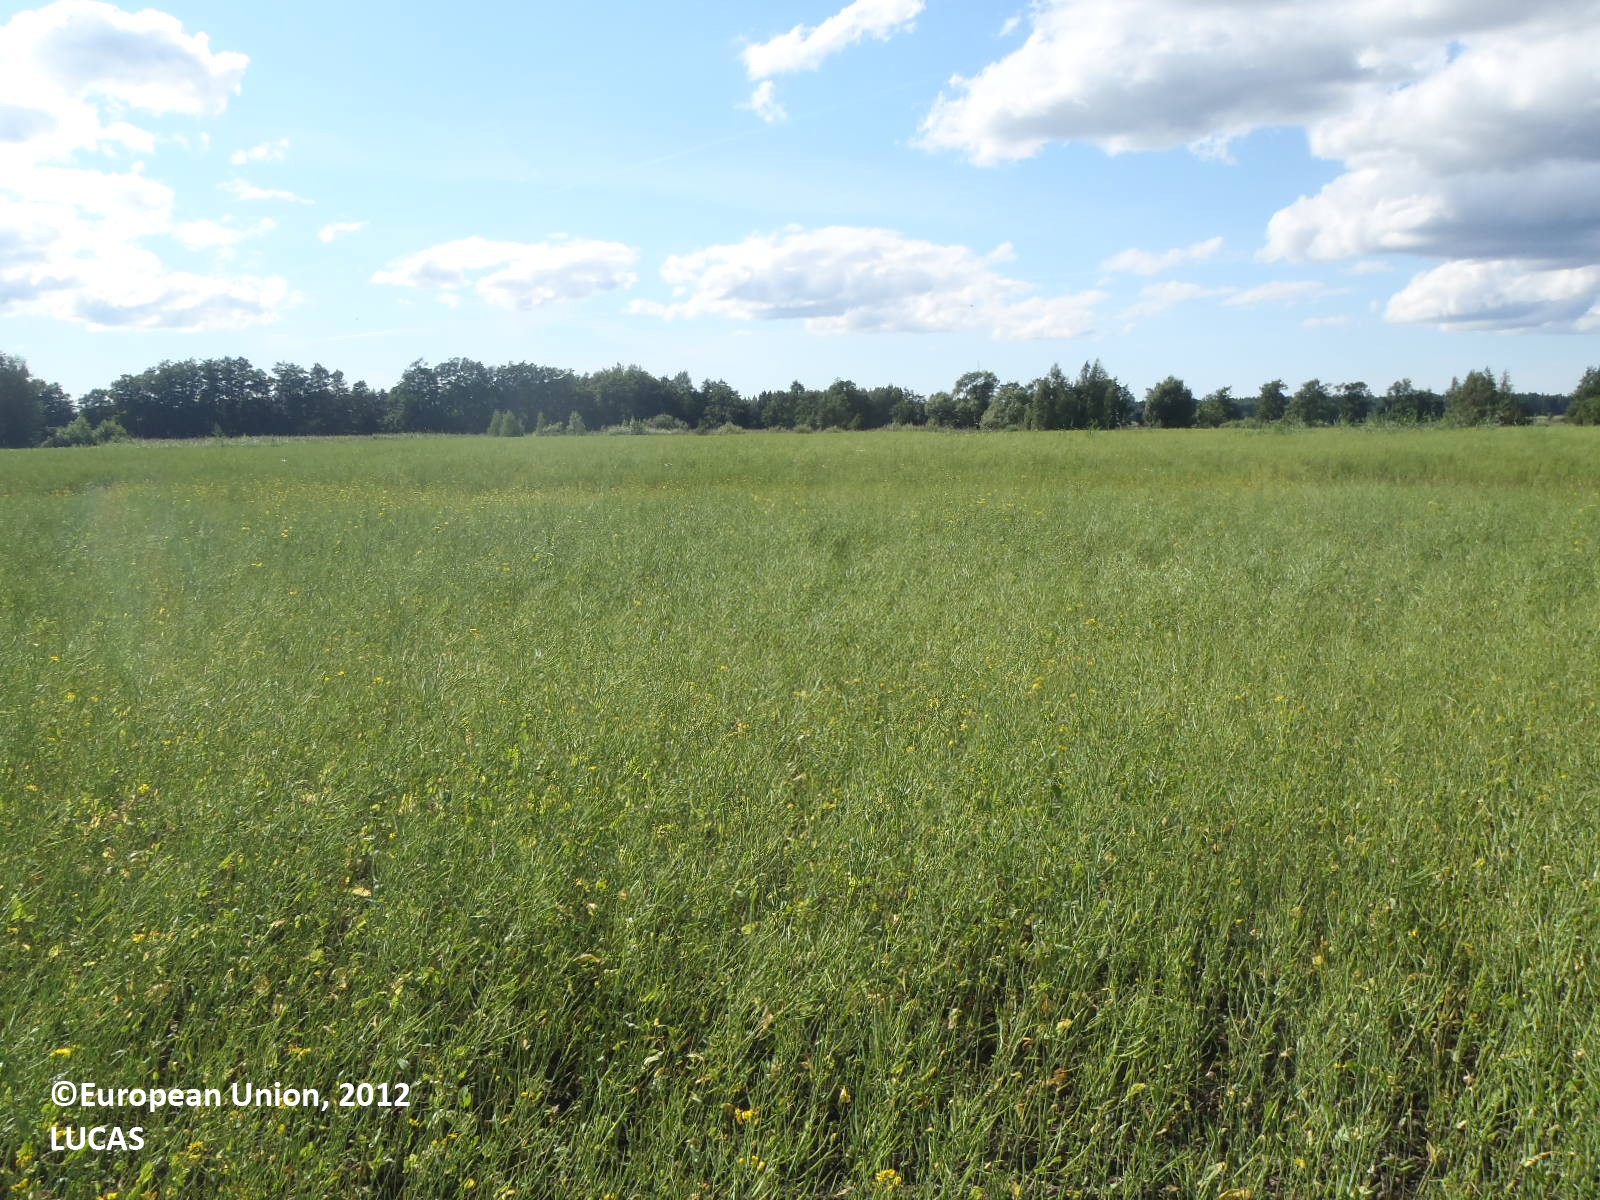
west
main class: Cropland
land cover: Rape and turnip rape
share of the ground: > 75 %
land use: Agriculture (excluding fallow land and kitchen gardens)
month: July
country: FI
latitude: 60.6452
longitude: 21.8556
